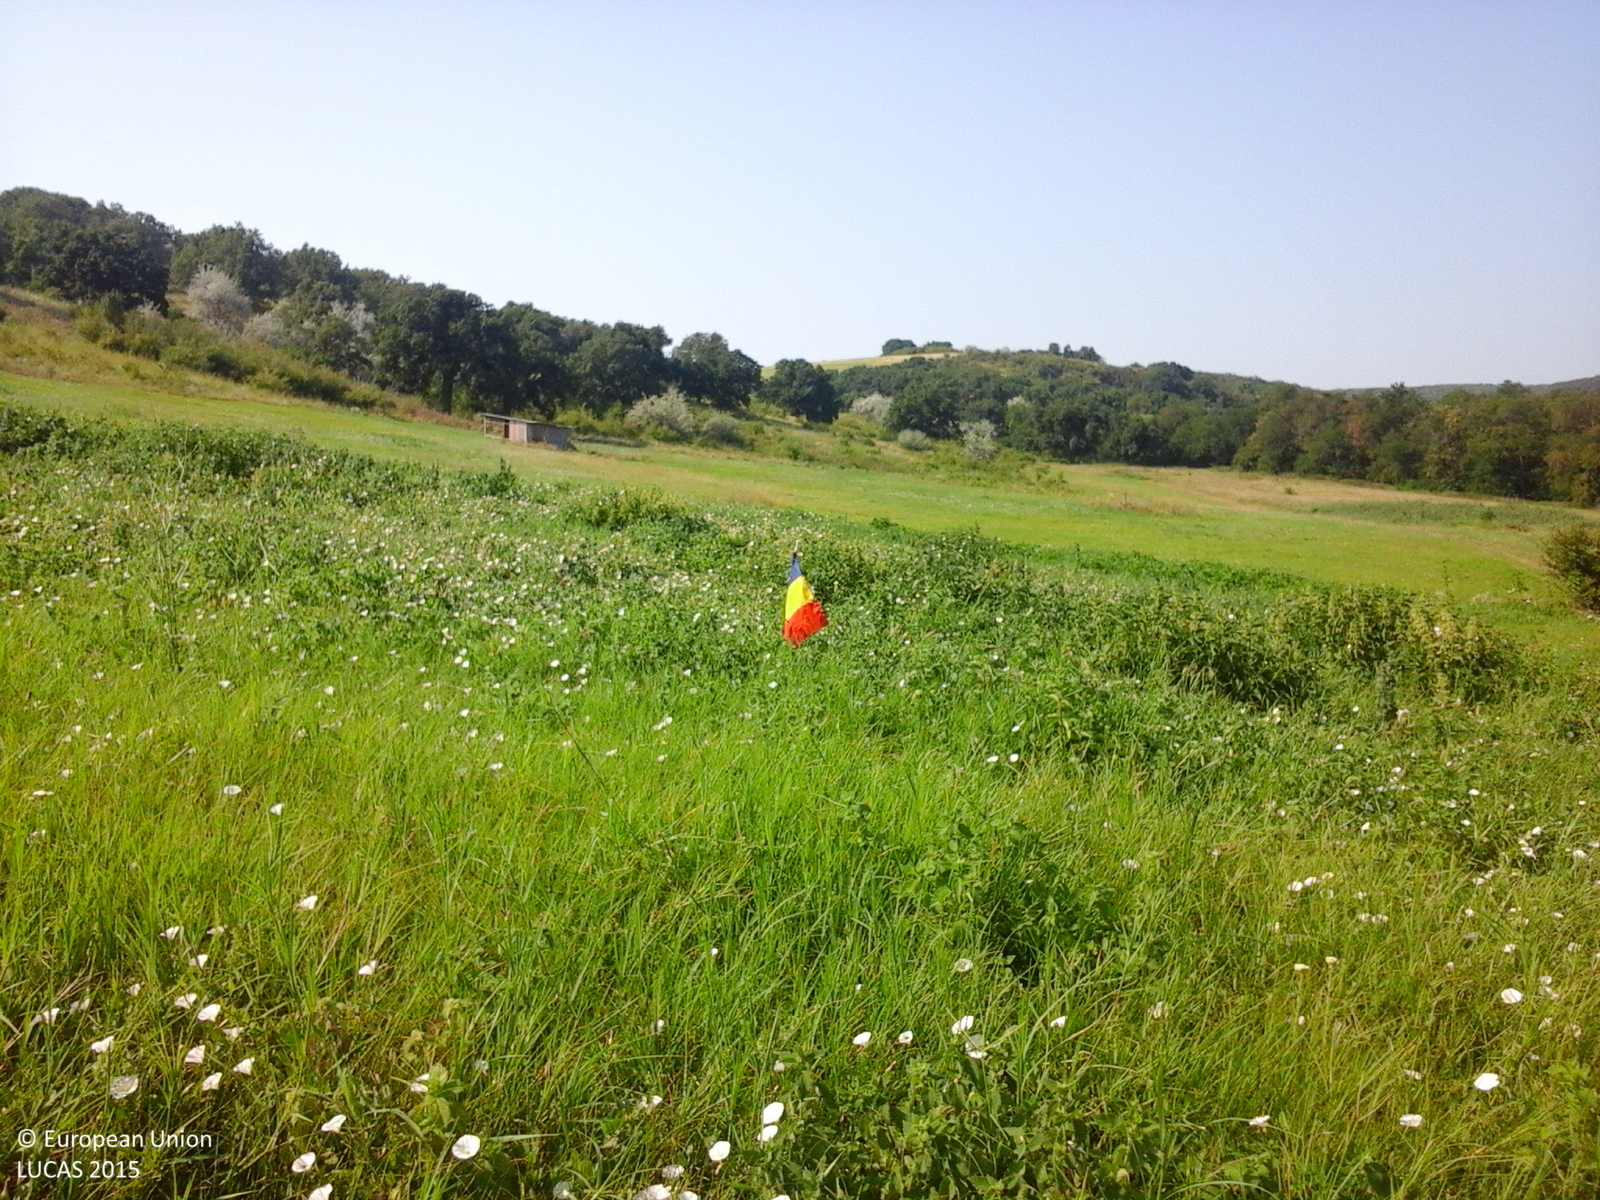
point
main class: Grassland
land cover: Grassland without tree/shrub cover
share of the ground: > 75 %
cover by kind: herbaceous plants 100 %
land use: Agriculture (excluding fallow land and kitchen gardens)
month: July
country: RO
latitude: 45.9788
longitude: 28.0522
